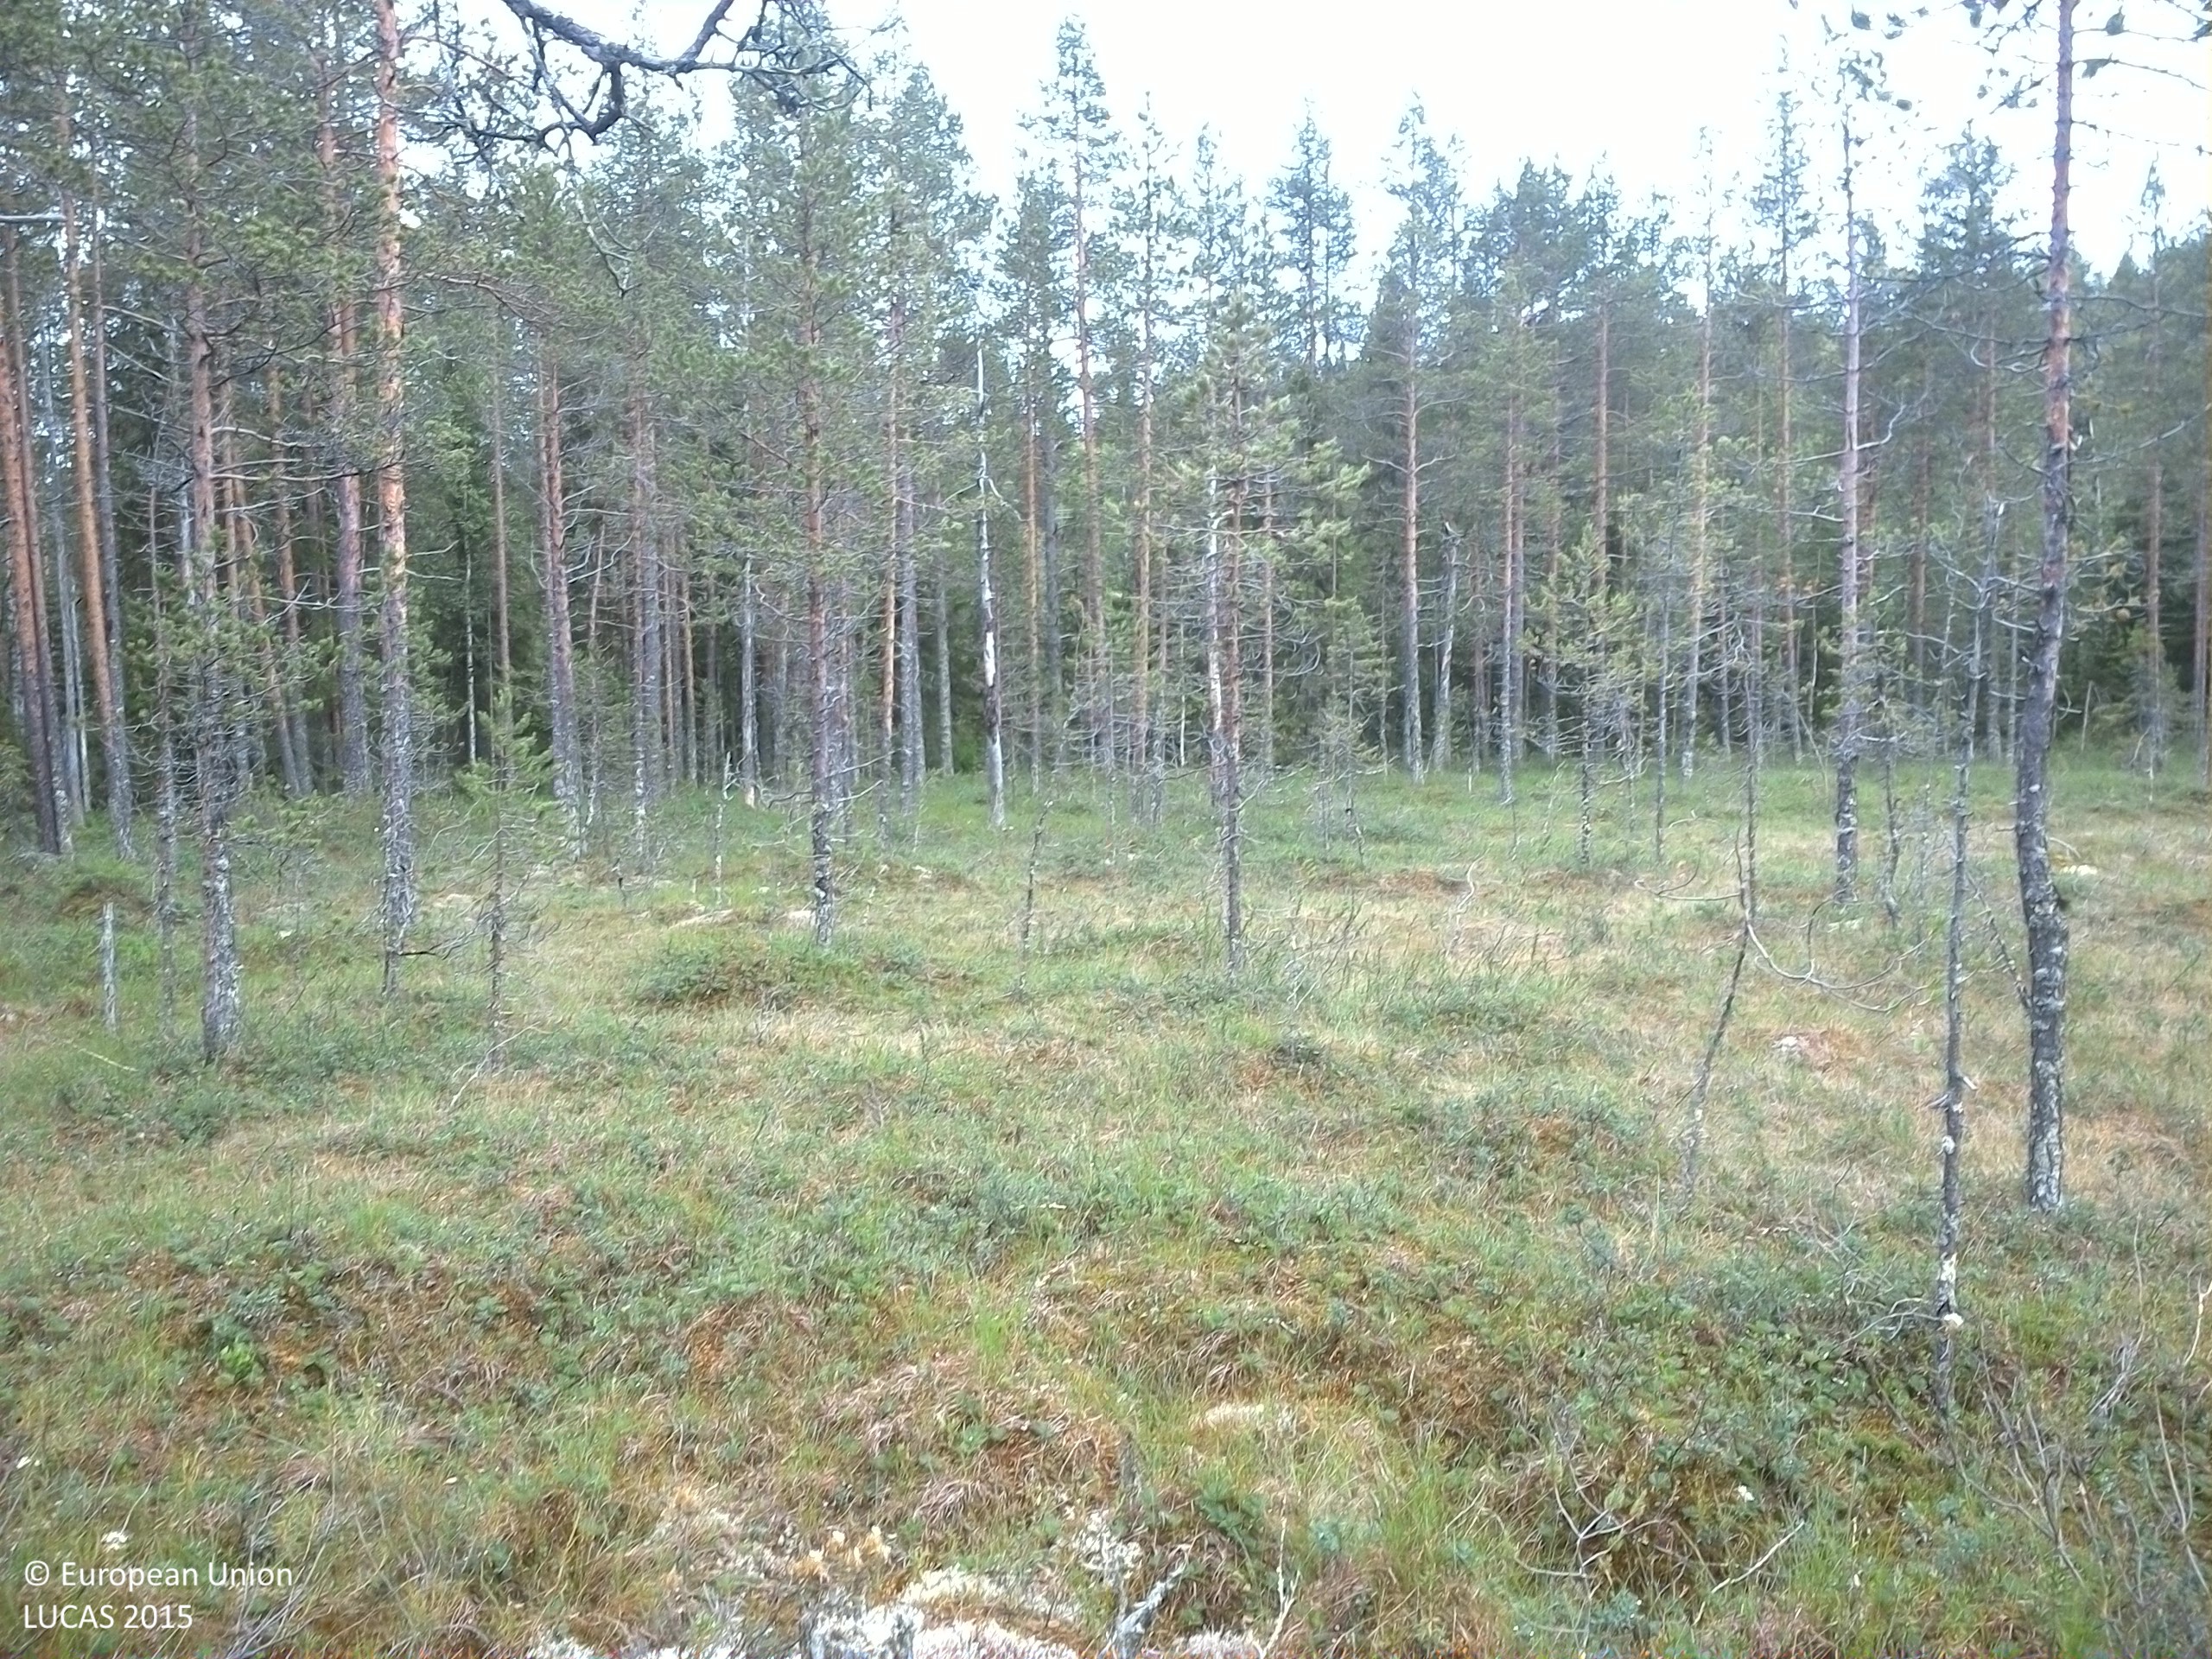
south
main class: Woodland
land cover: Pine dominated coniferous woodland
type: boreal forest
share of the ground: 10 - 25 %
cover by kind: lichens and mosses 80 %, coniferous forest trees 15 %, shrubs 5 %
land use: Semi-natural and natural areas not in use
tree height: > 5 m
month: July
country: SE
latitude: 63.6312
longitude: 18.7138
